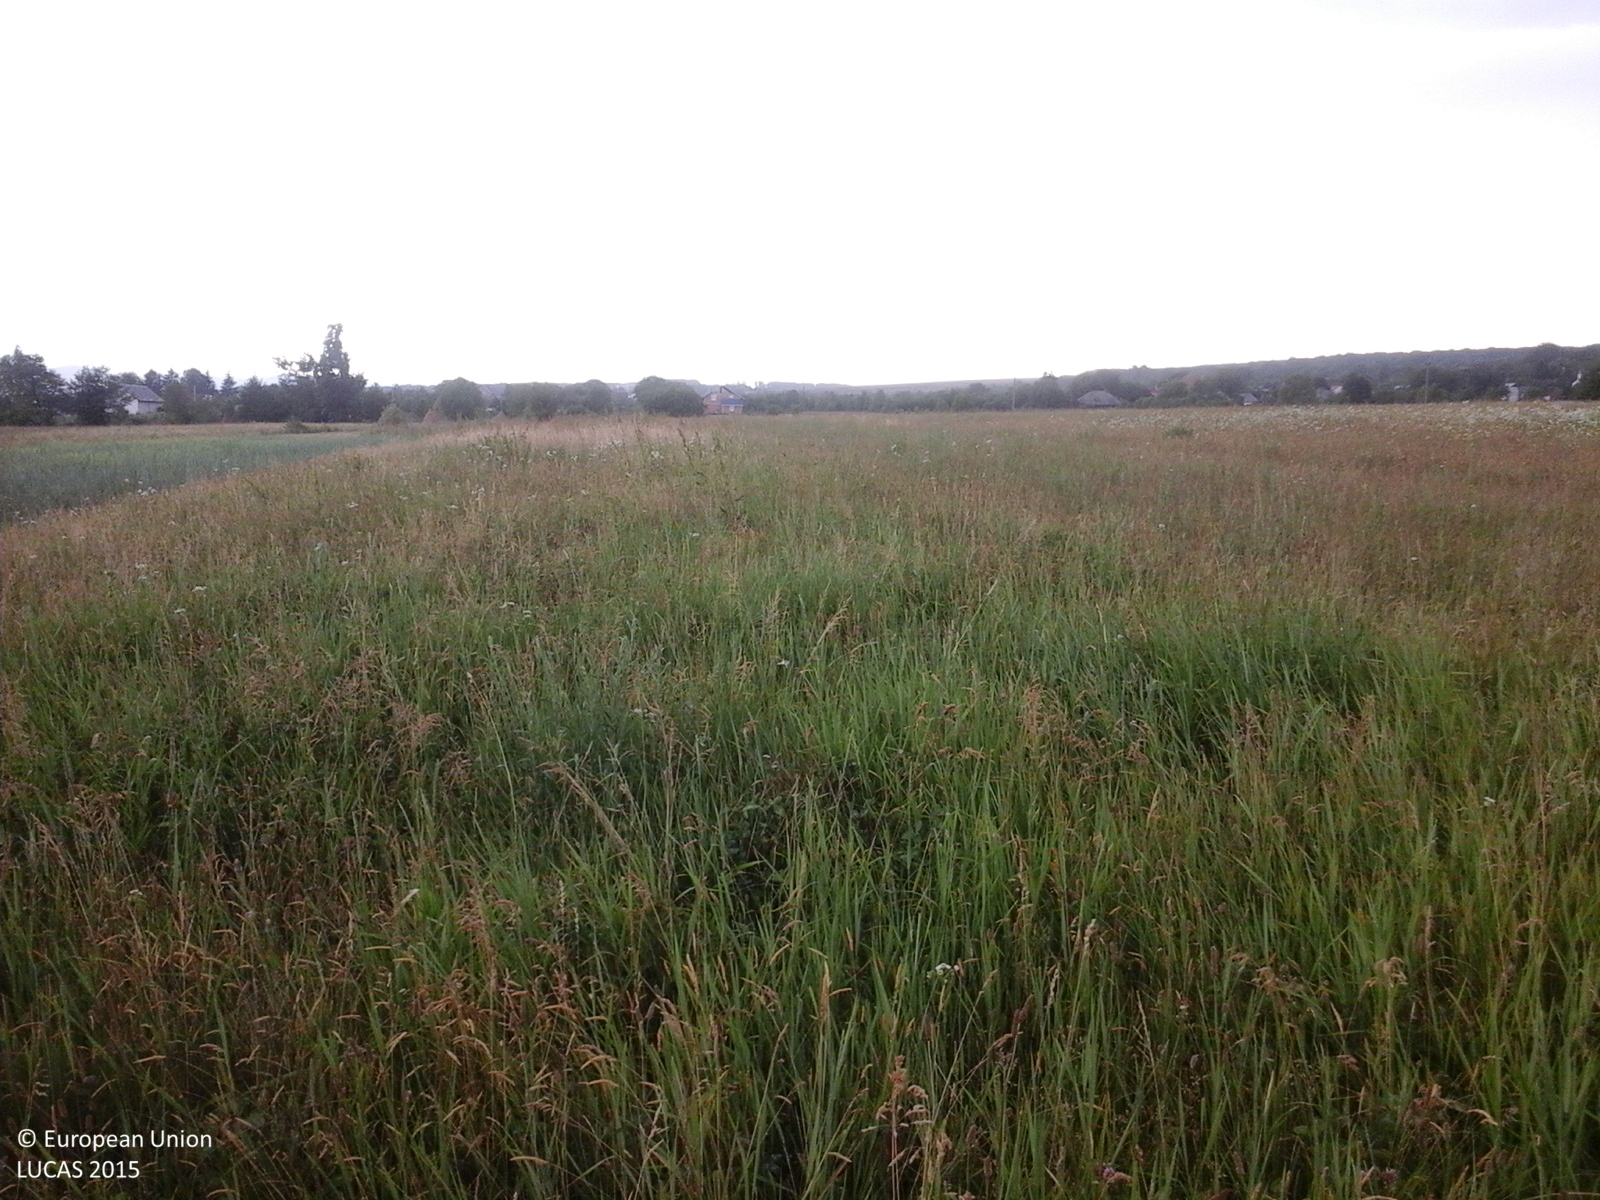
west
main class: Grassland
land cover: Grassland without tree/shrub cover
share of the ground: > 75 %
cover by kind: herbaceous plants 100 %
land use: Agriculture (excluding fallow land and kitchen gardens)
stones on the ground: < 10 %
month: June
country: RO
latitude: 47.3739
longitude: 26.2518
